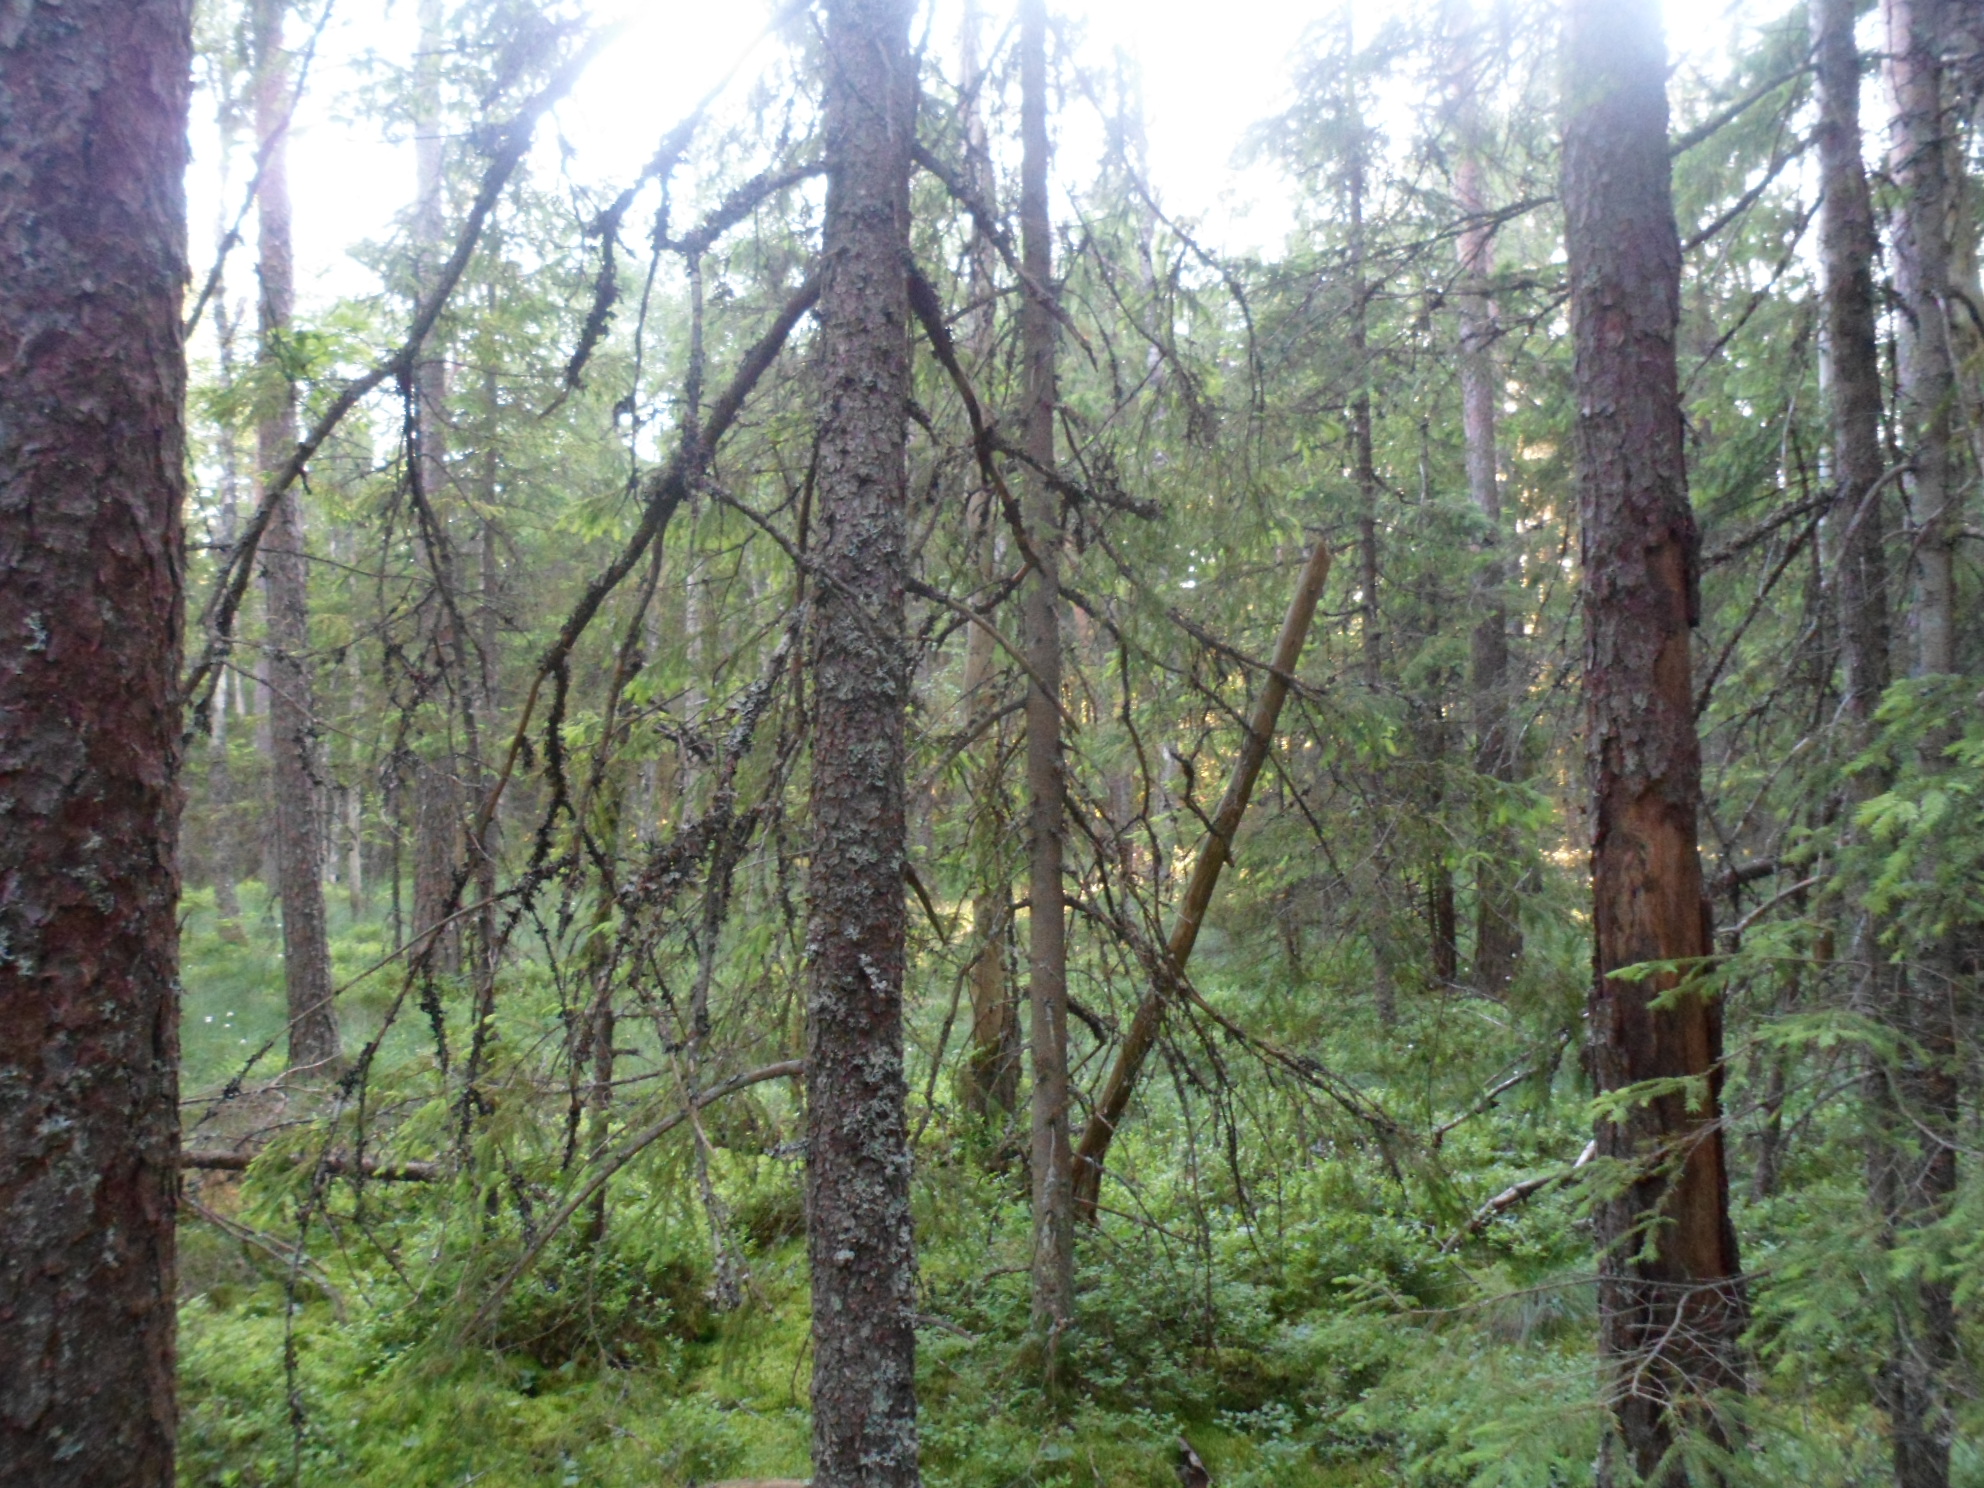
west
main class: Woodland
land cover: Pine dominated coniferous woodland
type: boreal forest
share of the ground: 50 - 75 %
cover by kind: coniferous forest trees 50 %, lichens and mosses 25 %, broadleaved forest trees 10 %, shrubs 10 %, herbaceous plants 5 %
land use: Forestry
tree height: > 5 m
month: July
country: SE
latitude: 57.5164
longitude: 14.4197
